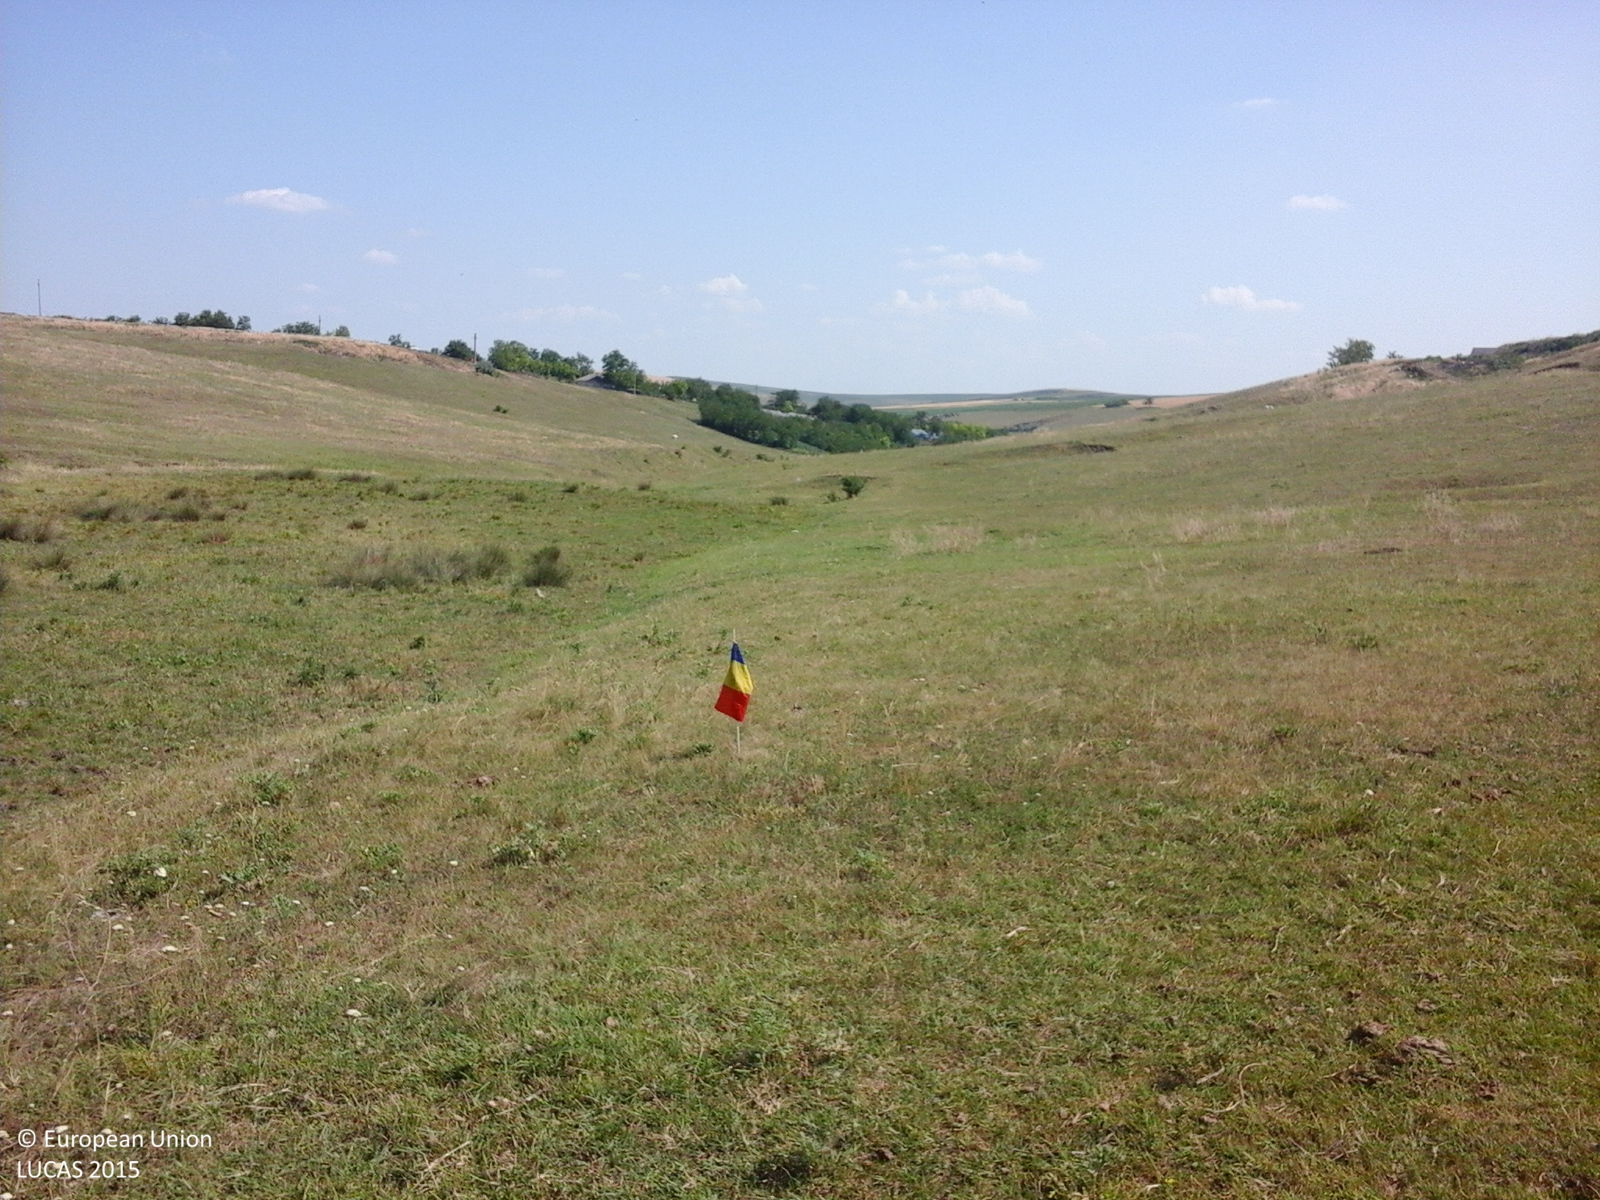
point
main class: Grassland
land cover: Grassland without tree/shrub cover
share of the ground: > 75 %
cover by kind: herbaceous plants 100 %
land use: Agriculture (excluding fallow land and kitchen gardens)
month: June
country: RO
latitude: 47.3639
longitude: 27.2571
